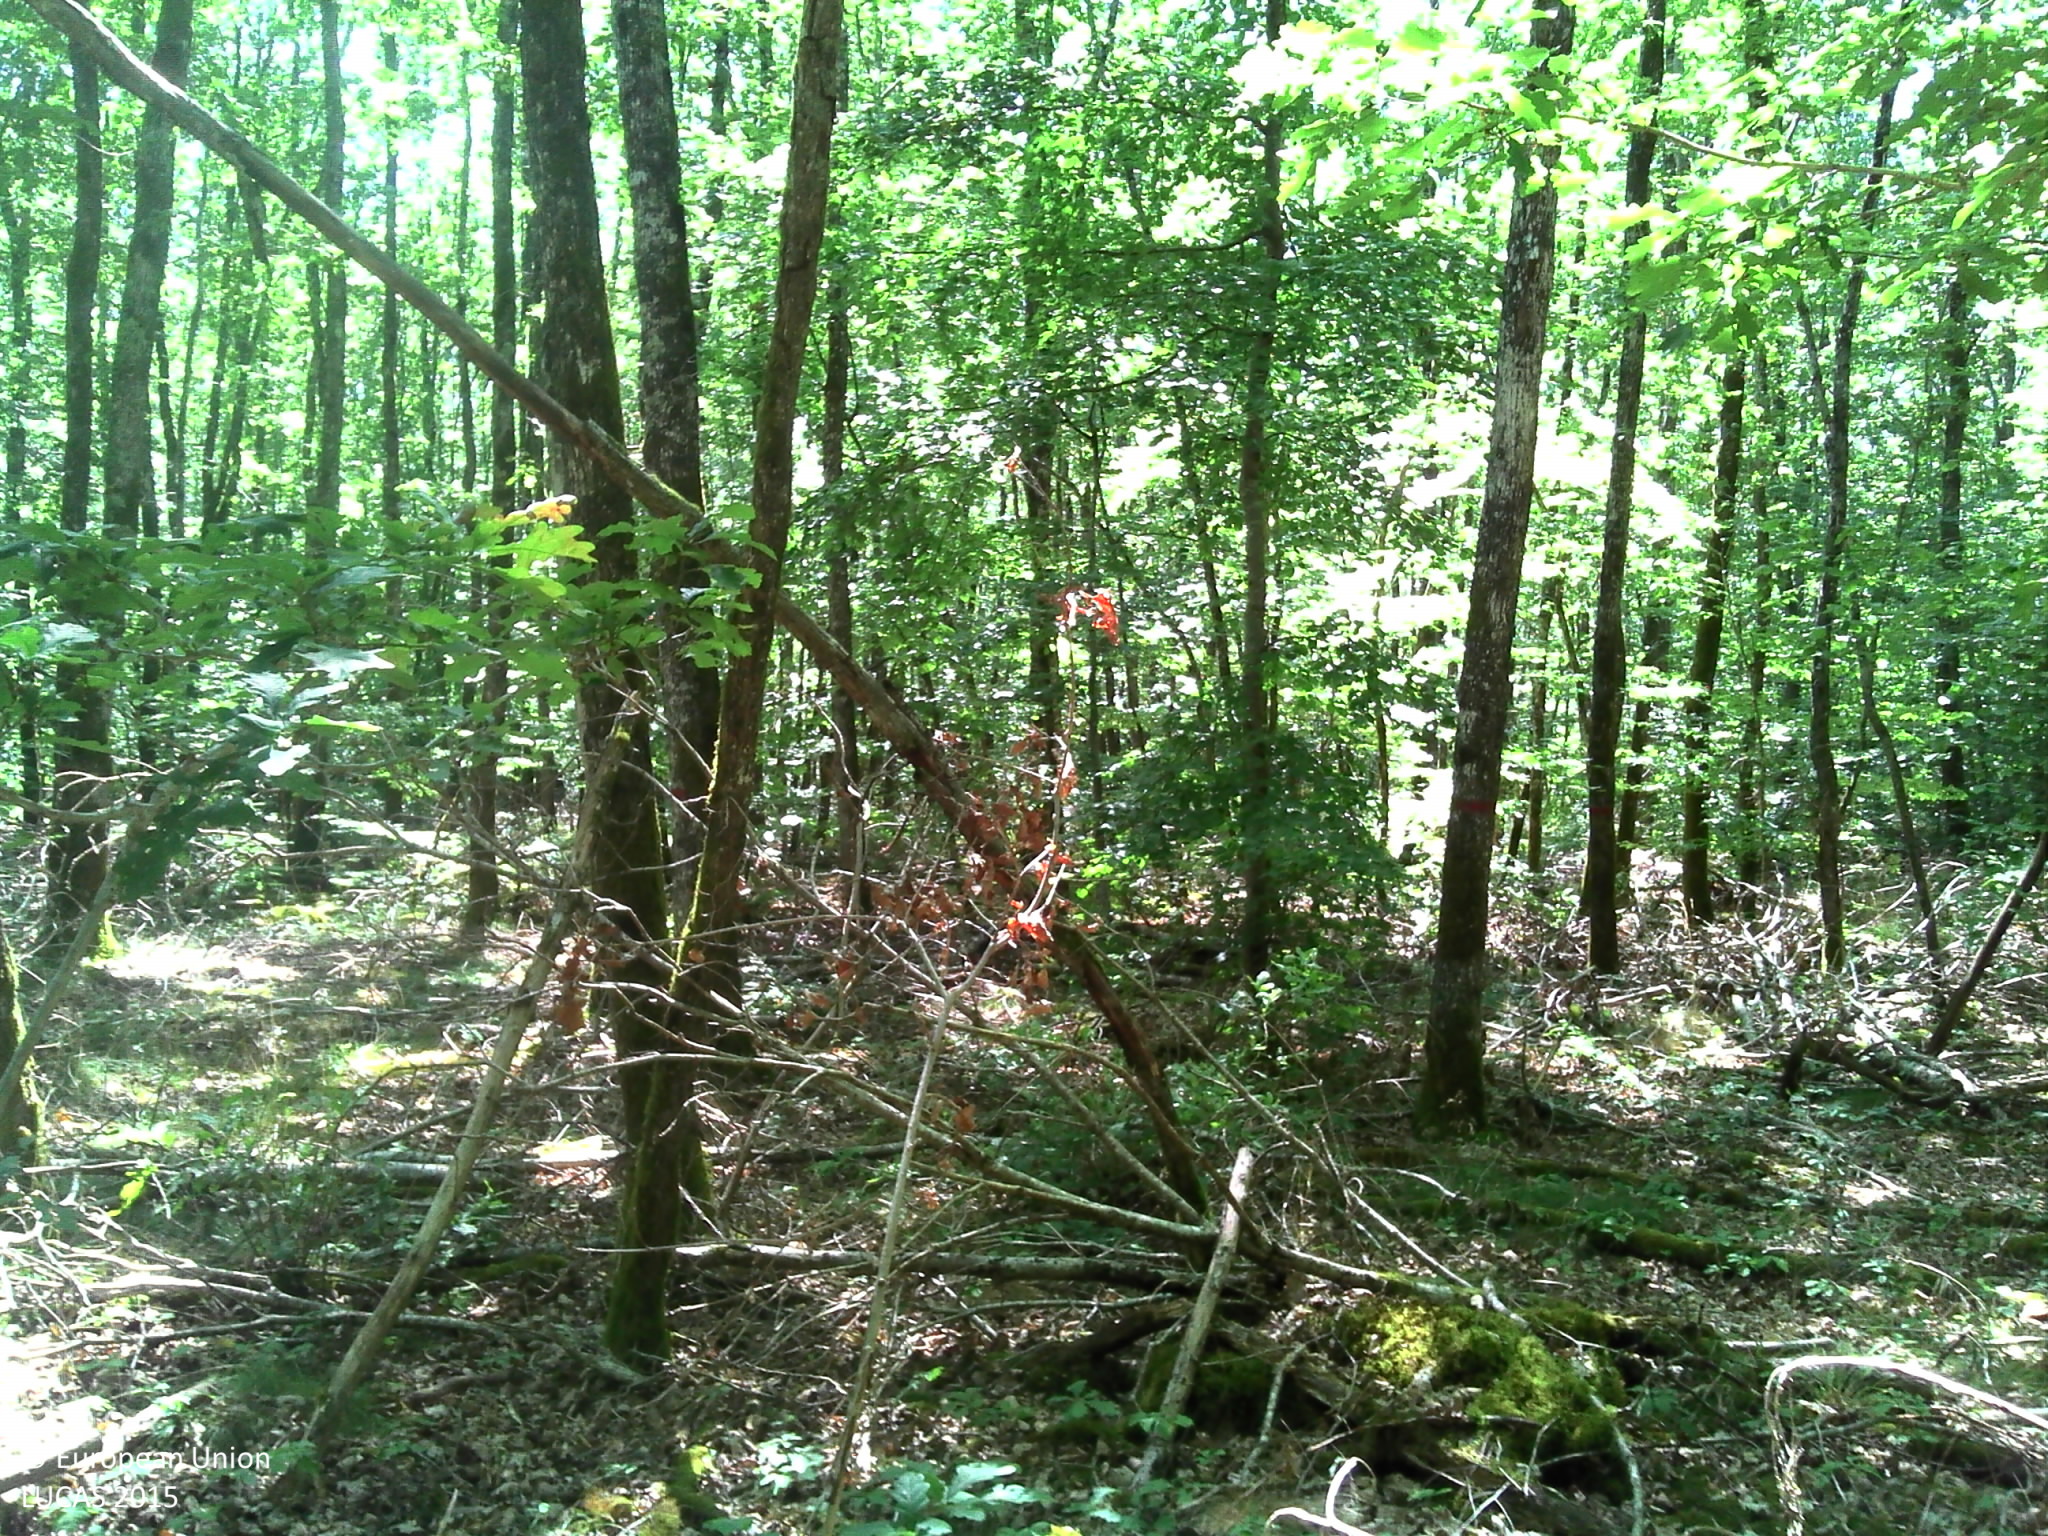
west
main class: Woodland
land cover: Broadleaved woodland
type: mesophytic deciduous forest
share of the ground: > 75 %
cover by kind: broadleaved forest trees 100 %
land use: Forestry
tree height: > 5 m
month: July
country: FR
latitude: 47.0948
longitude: 3.2378
